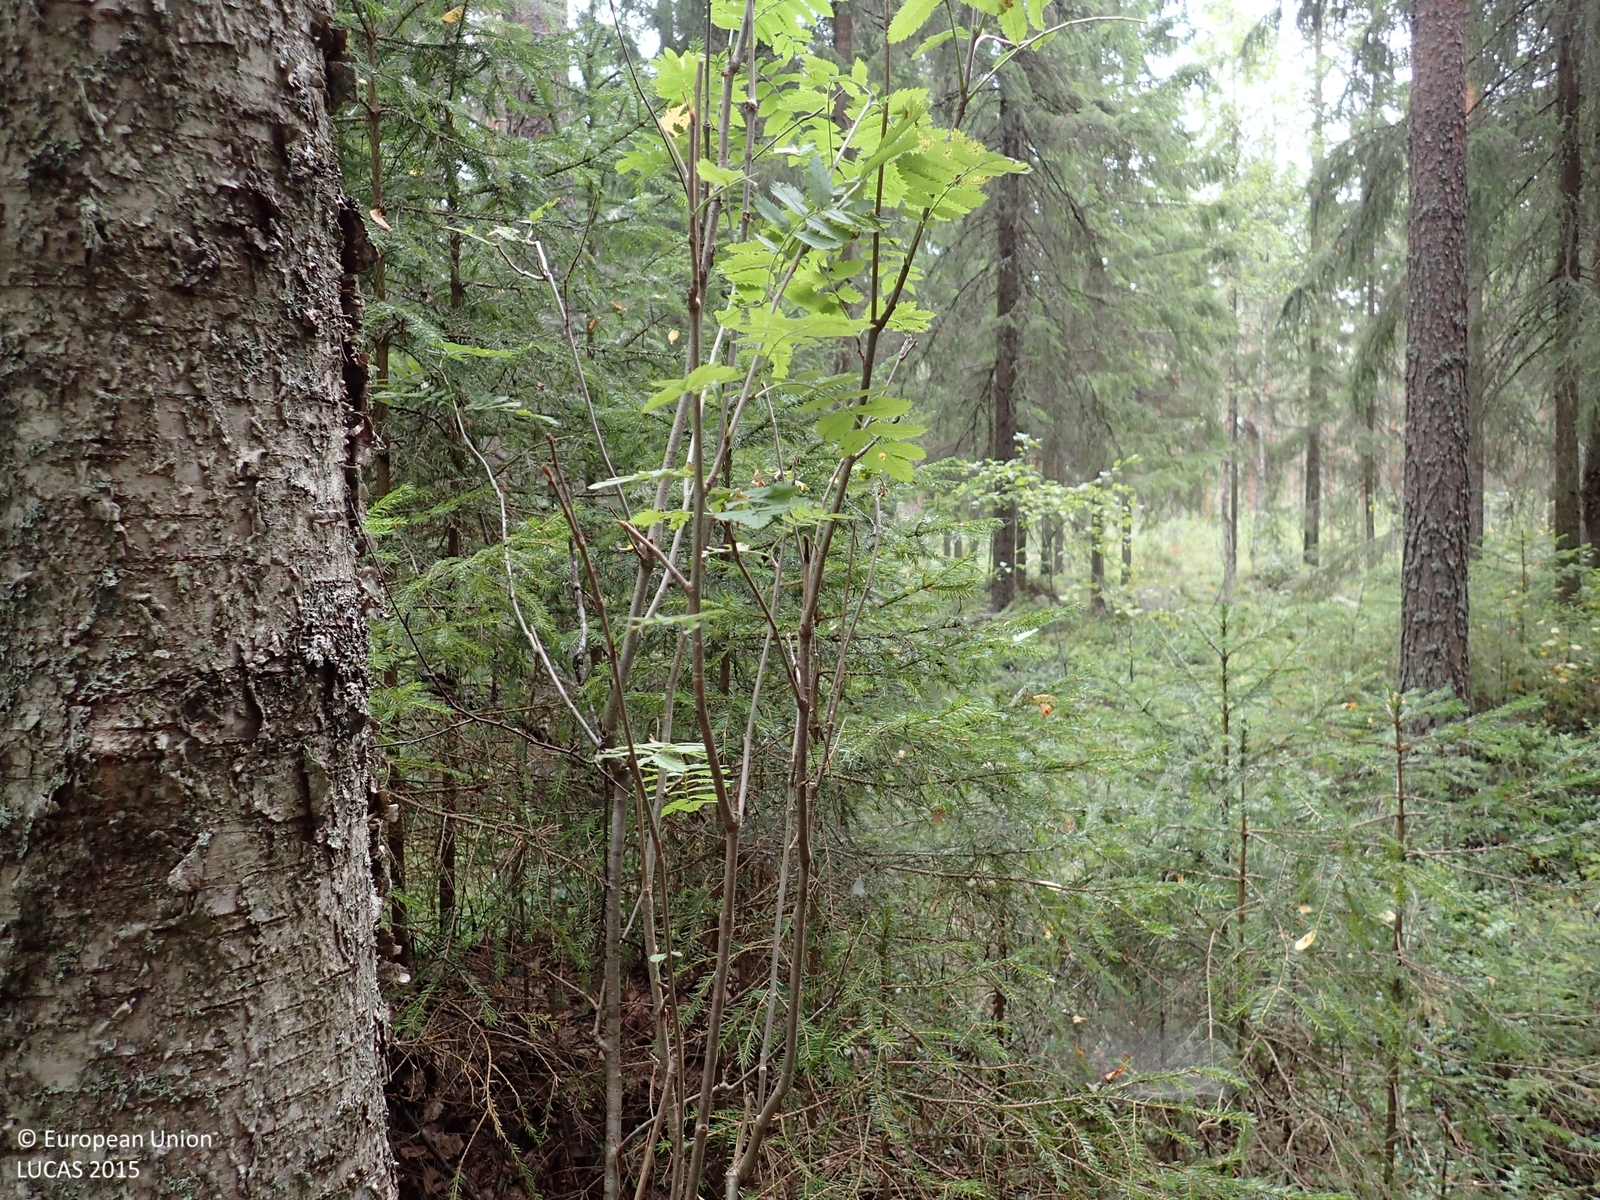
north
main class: Woodland
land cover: Other coniferous woodland
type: boreal forest
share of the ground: > 75 %
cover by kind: coniferous forest trees 70 %, shrubs 15 %, broadleaved forest trees 10 %, lichens and mosses 5 %
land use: Forestry
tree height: > 5 m
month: August
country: FI
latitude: 62.6656
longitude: 22.6078
